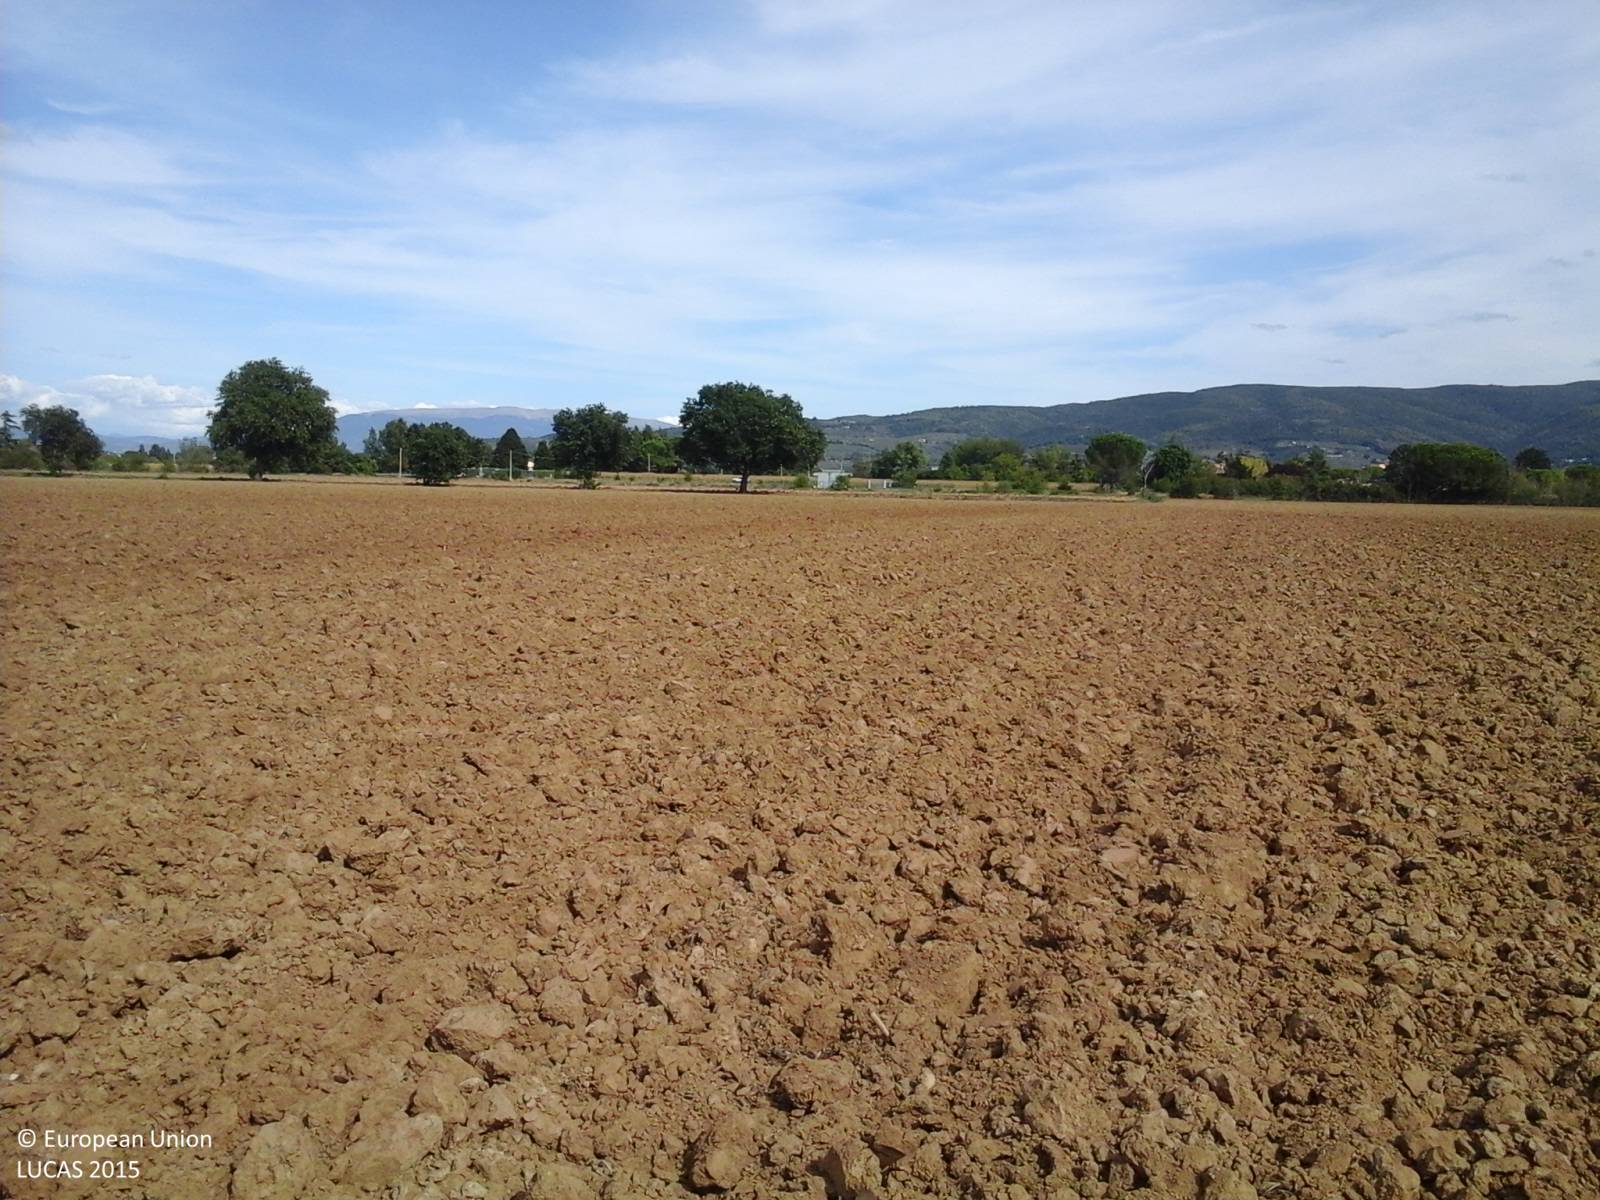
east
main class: Cropland
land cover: Maize
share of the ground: > 75 %
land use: Agriculture (excluding fallow land and kitchen gardens)
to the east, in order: Maize; Ditches and canals; Grass margins; Durum wheat
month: September
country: IT
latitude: 43.0053
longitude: 12.3851
